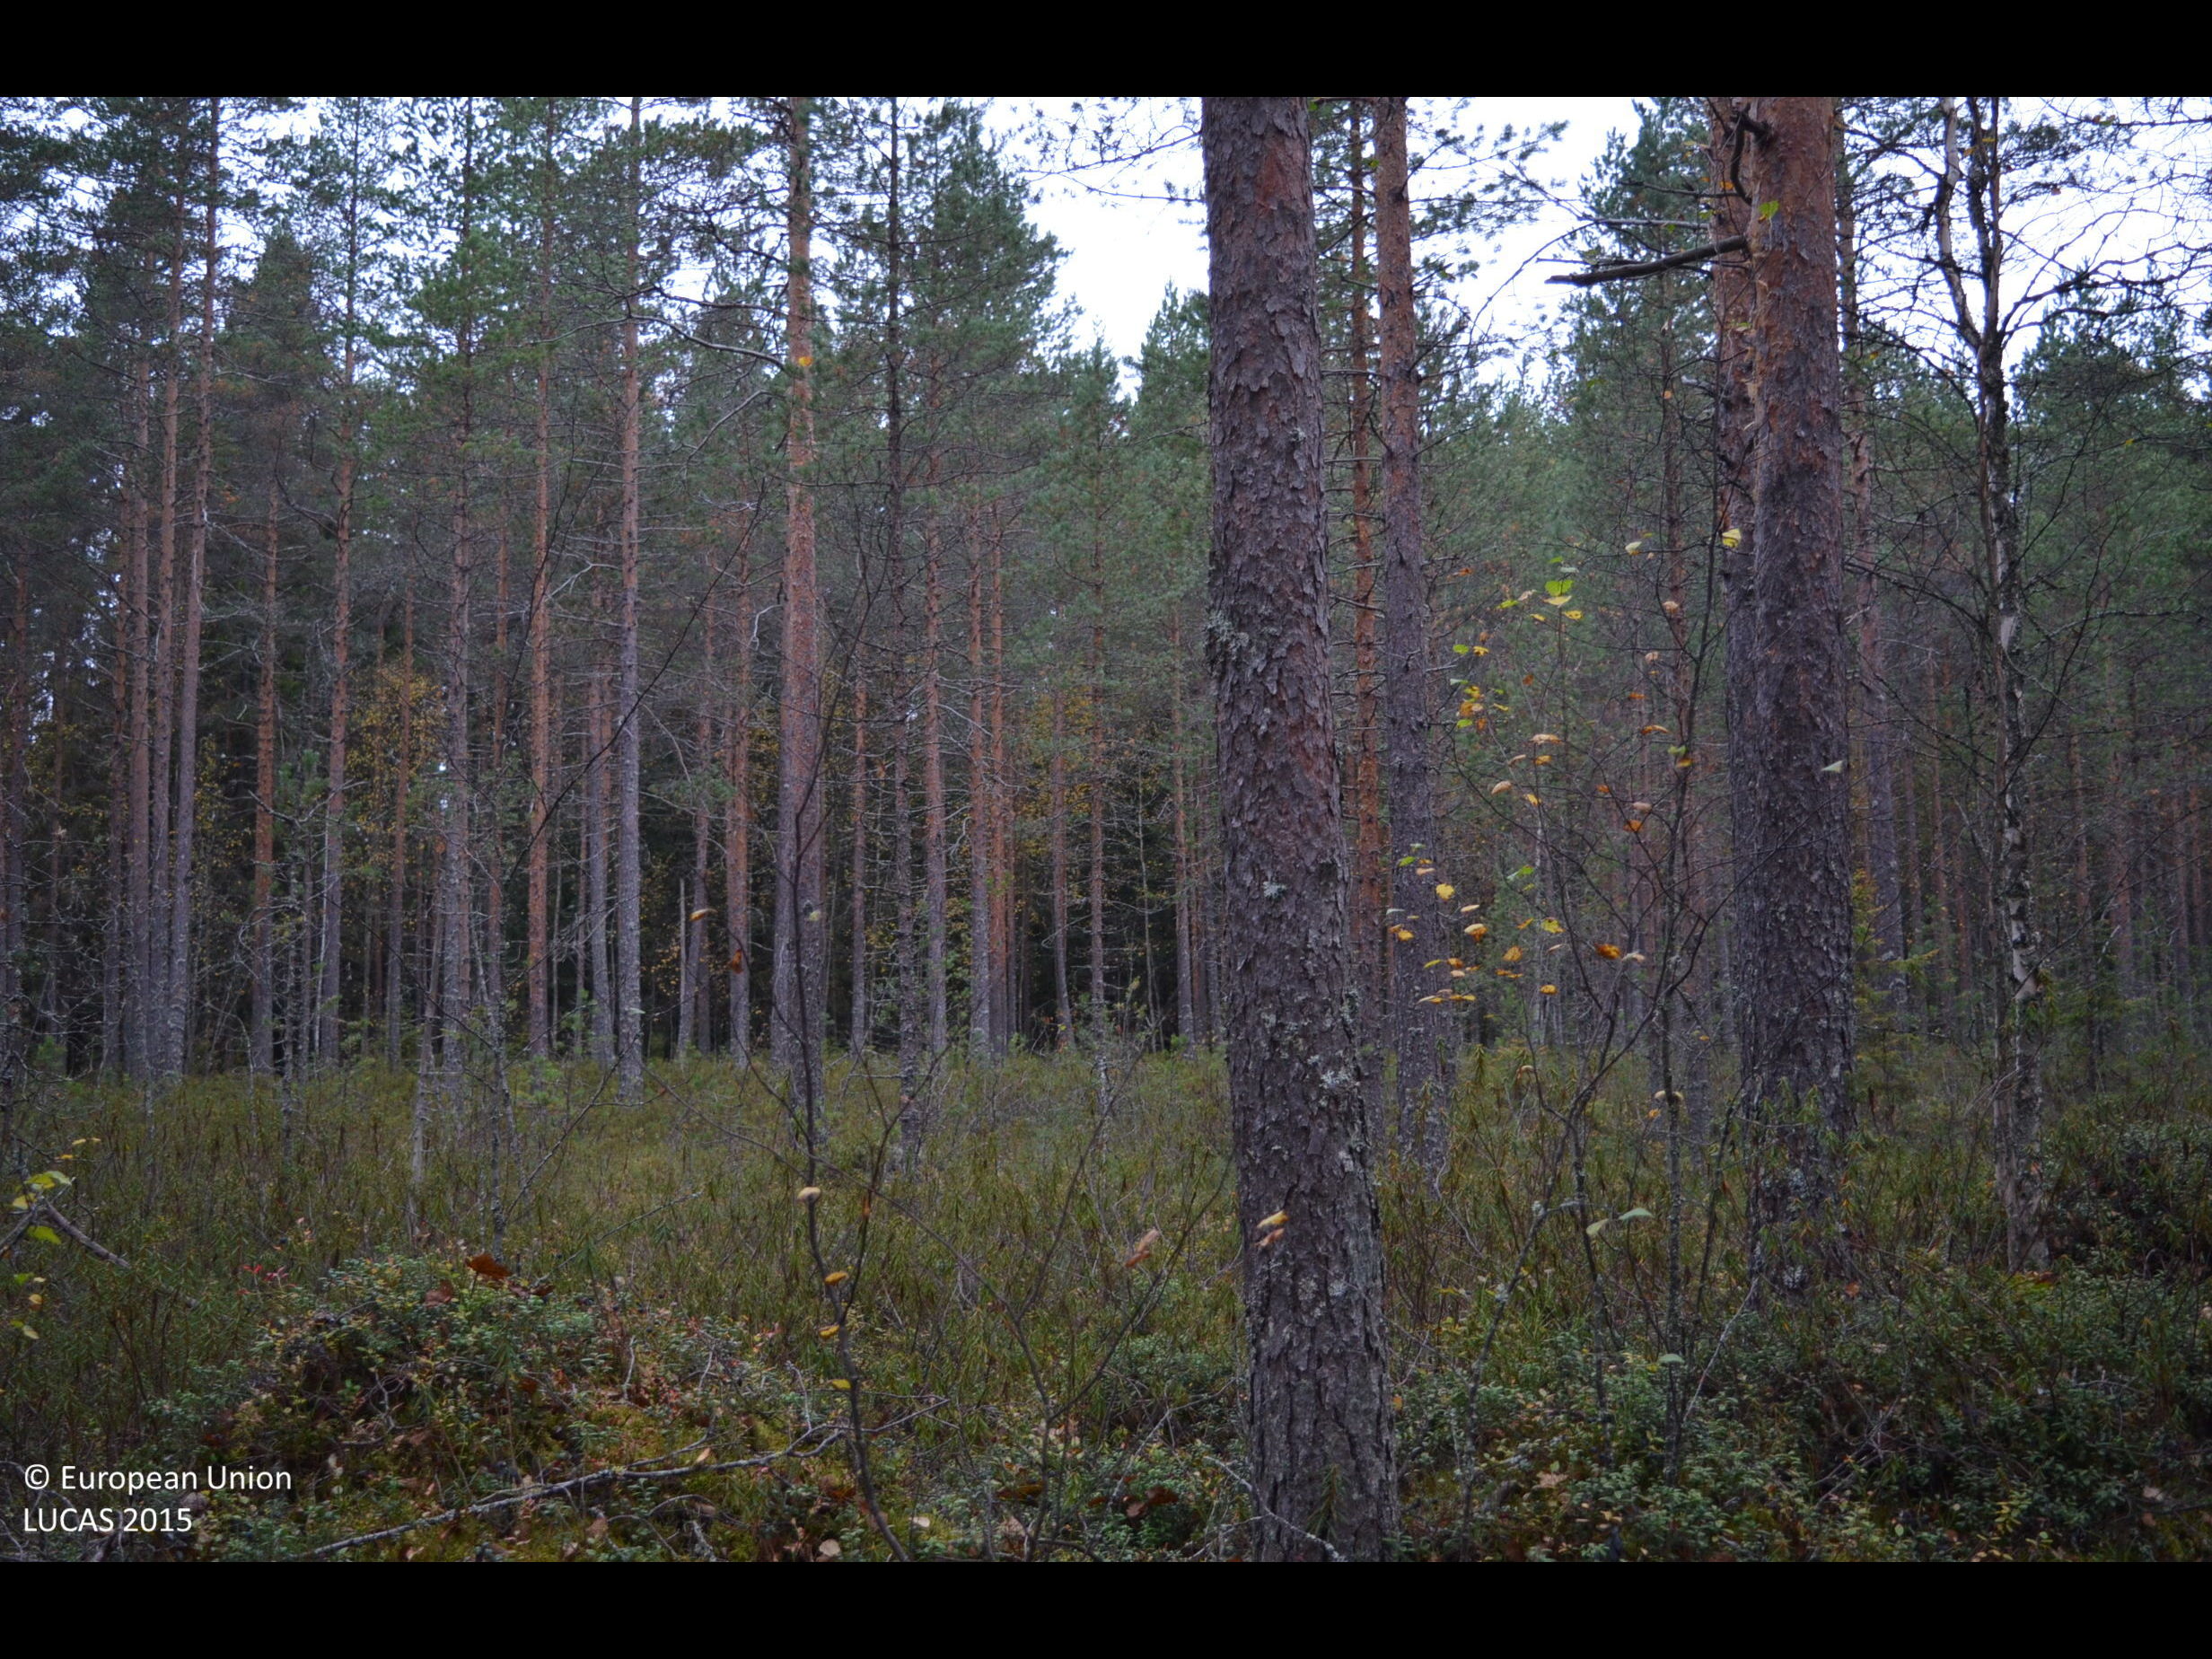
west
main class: Woodland
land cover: Pine dominated coniferous woodland
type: boreal forest
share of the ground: > 75 %
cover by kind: coniferous forest trees 65 %, shrubs 25 %, broadleaved forest trees 10 %
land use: Forestry
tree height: > 5 m
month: September
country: FI
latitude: 62.4732
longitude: 23.7492
